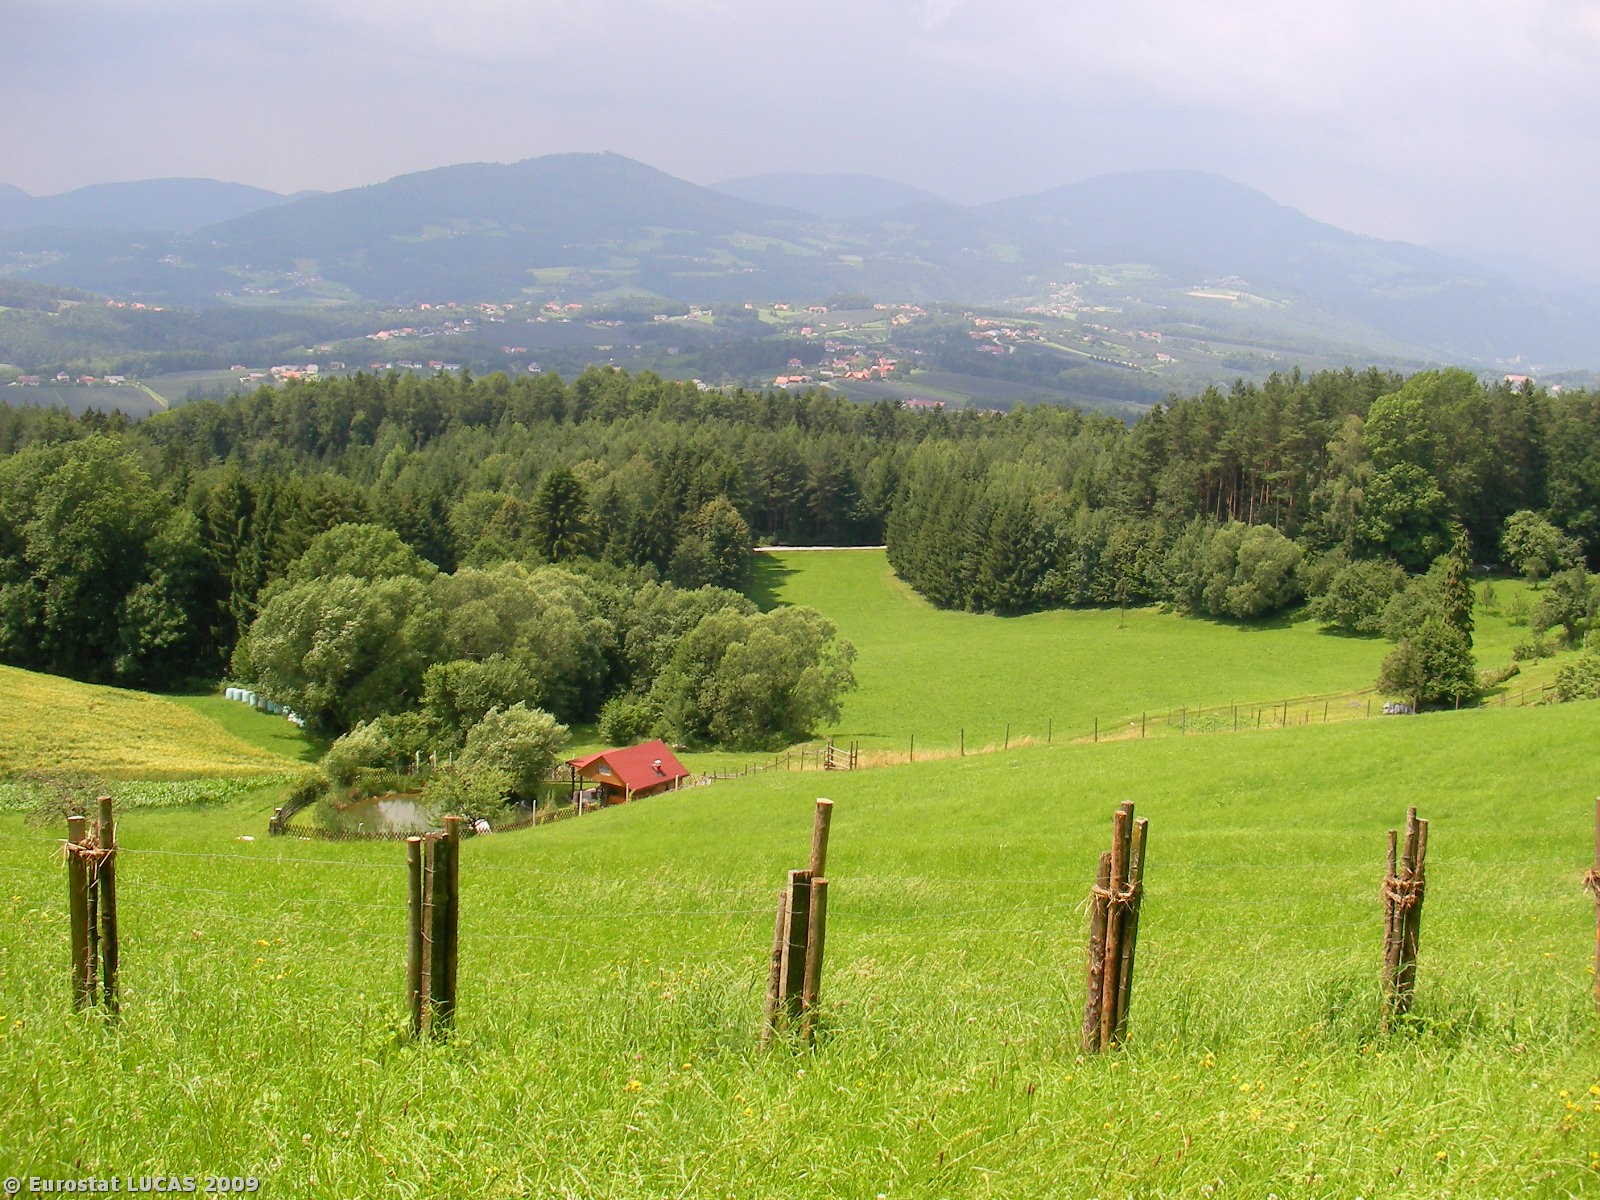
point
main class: Grassland
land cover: Grassland without tree/shrub cover
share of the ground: > 75 %
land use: Agriculture (excluding fallow land and kitchen gardens)
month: July
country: AT
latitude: 47.2257
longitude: 15.7458
